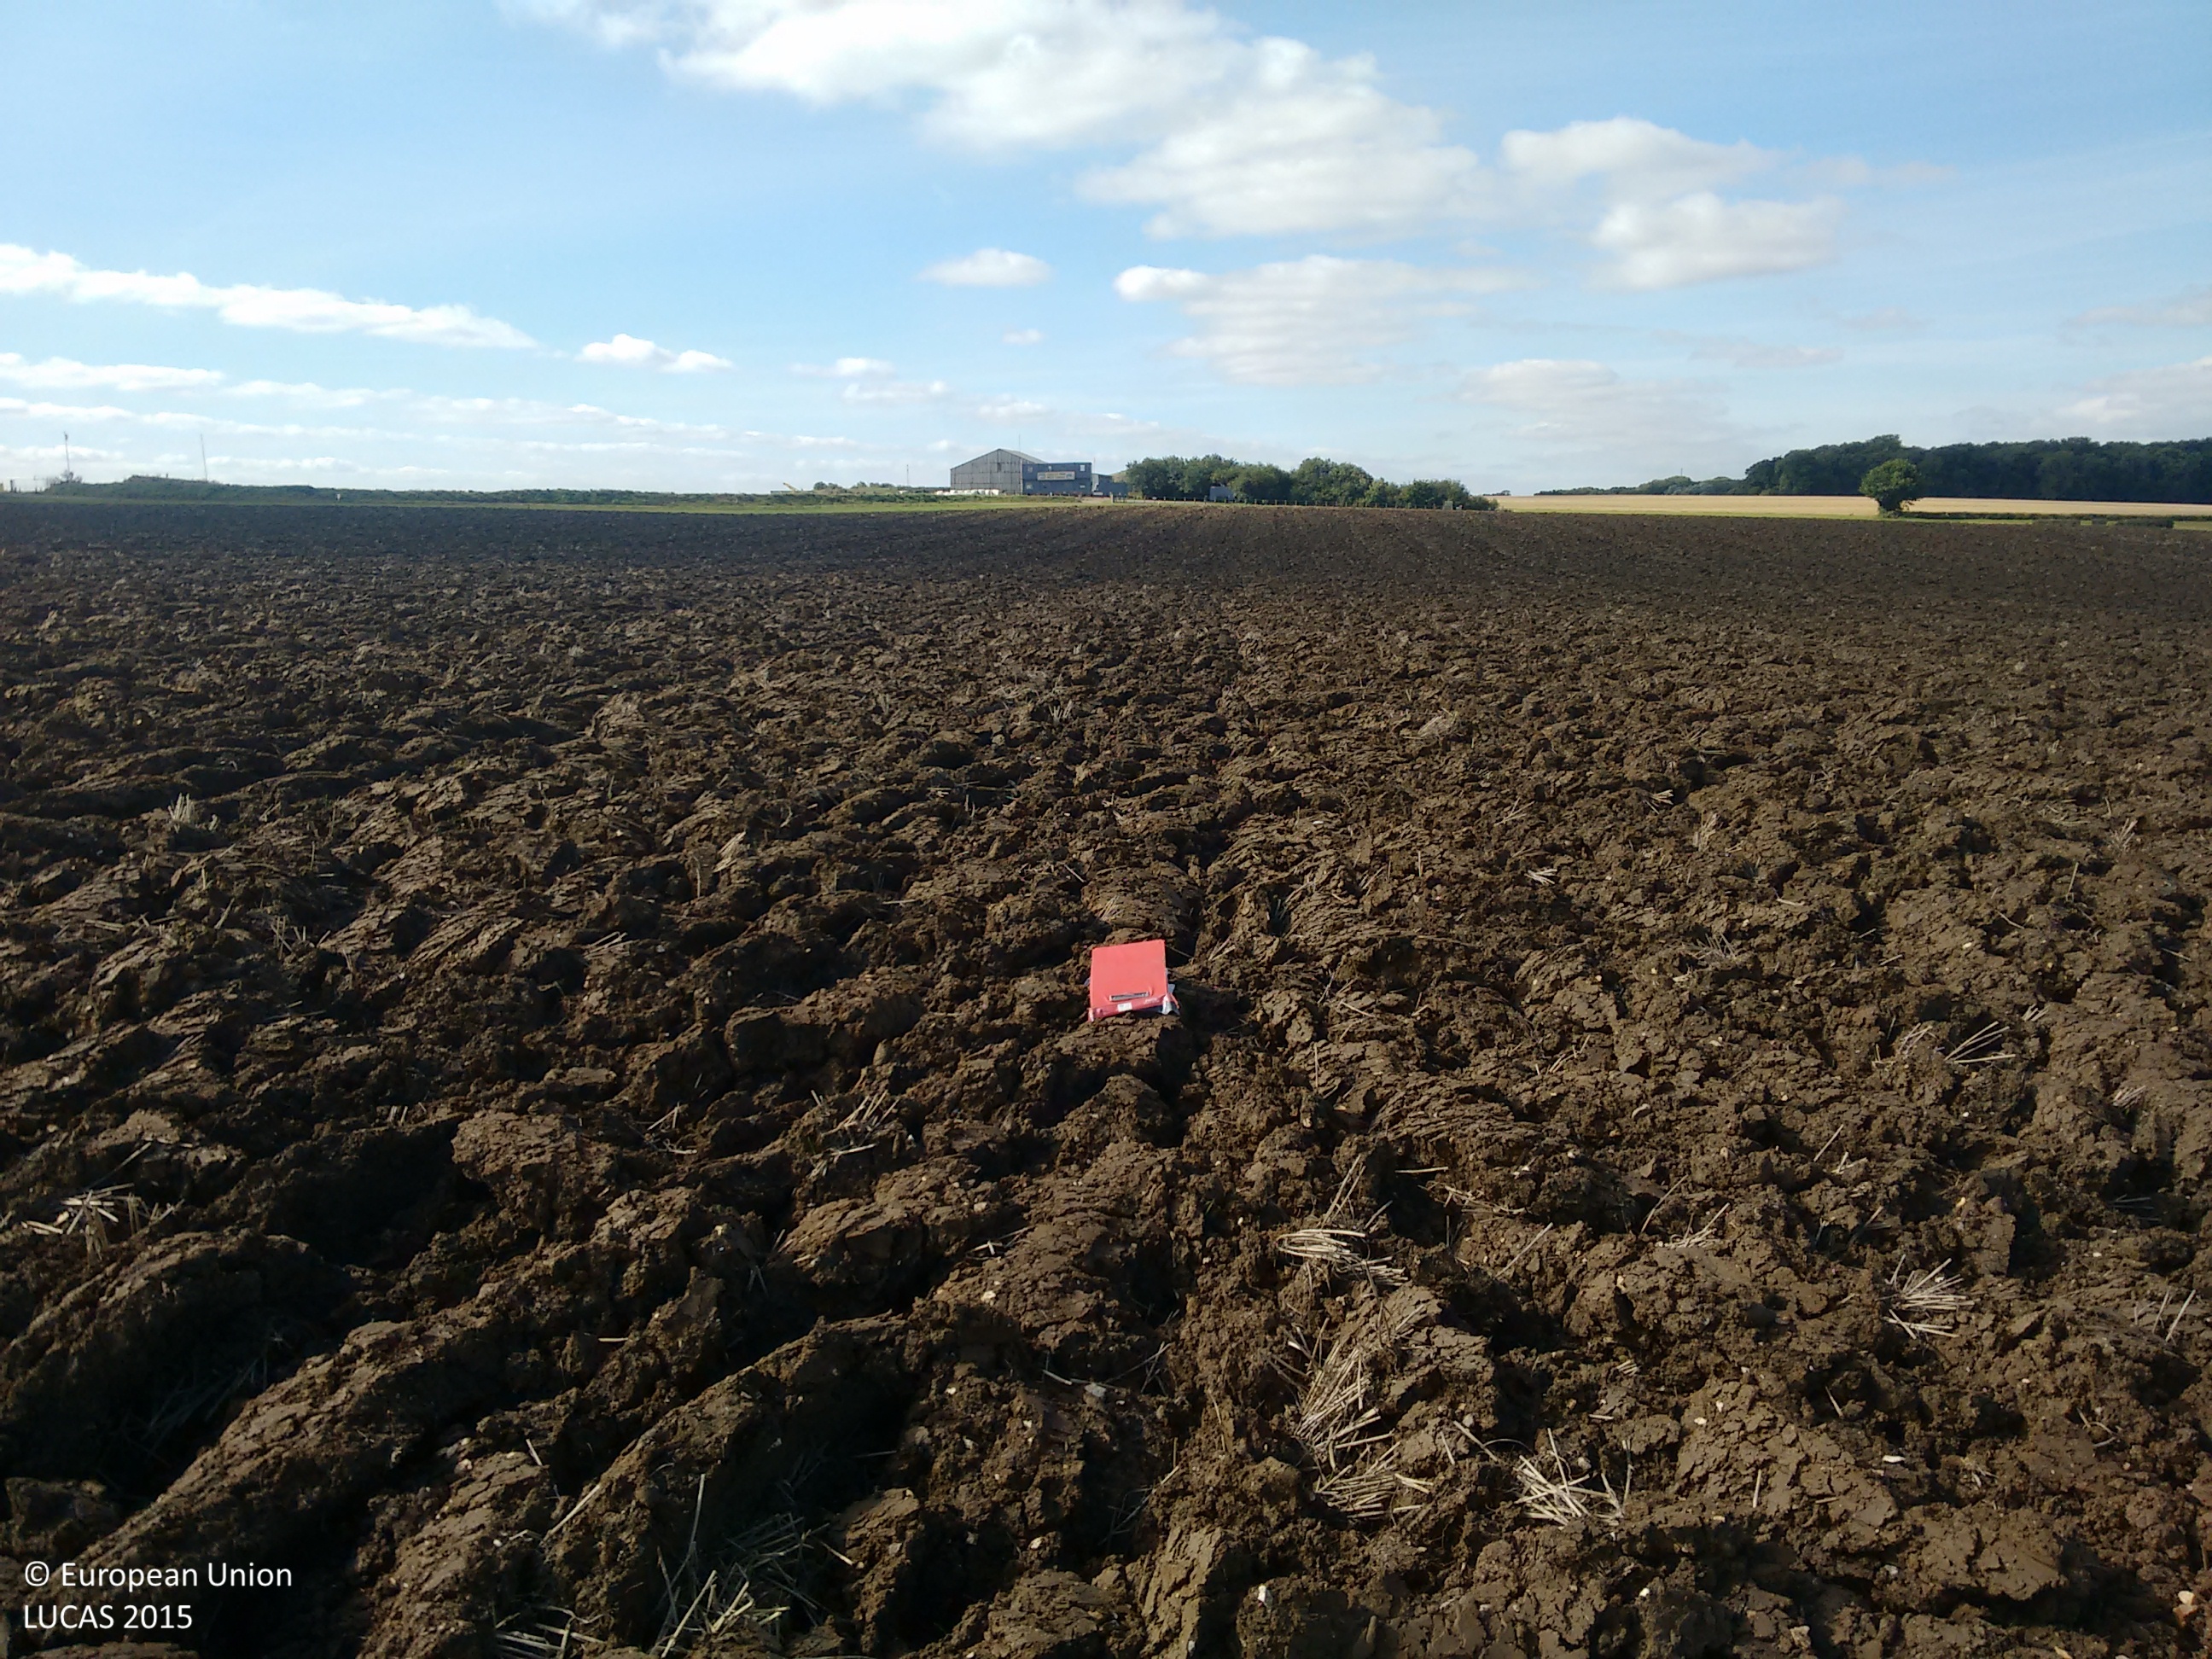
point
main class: Cropland
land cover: Common wheat
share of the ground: < 10 %
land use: Agriculture (excluding fallow land and kitchen gardens)
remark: Harvested field
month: September
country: GB
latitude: 51.9971
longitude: 0.0785
